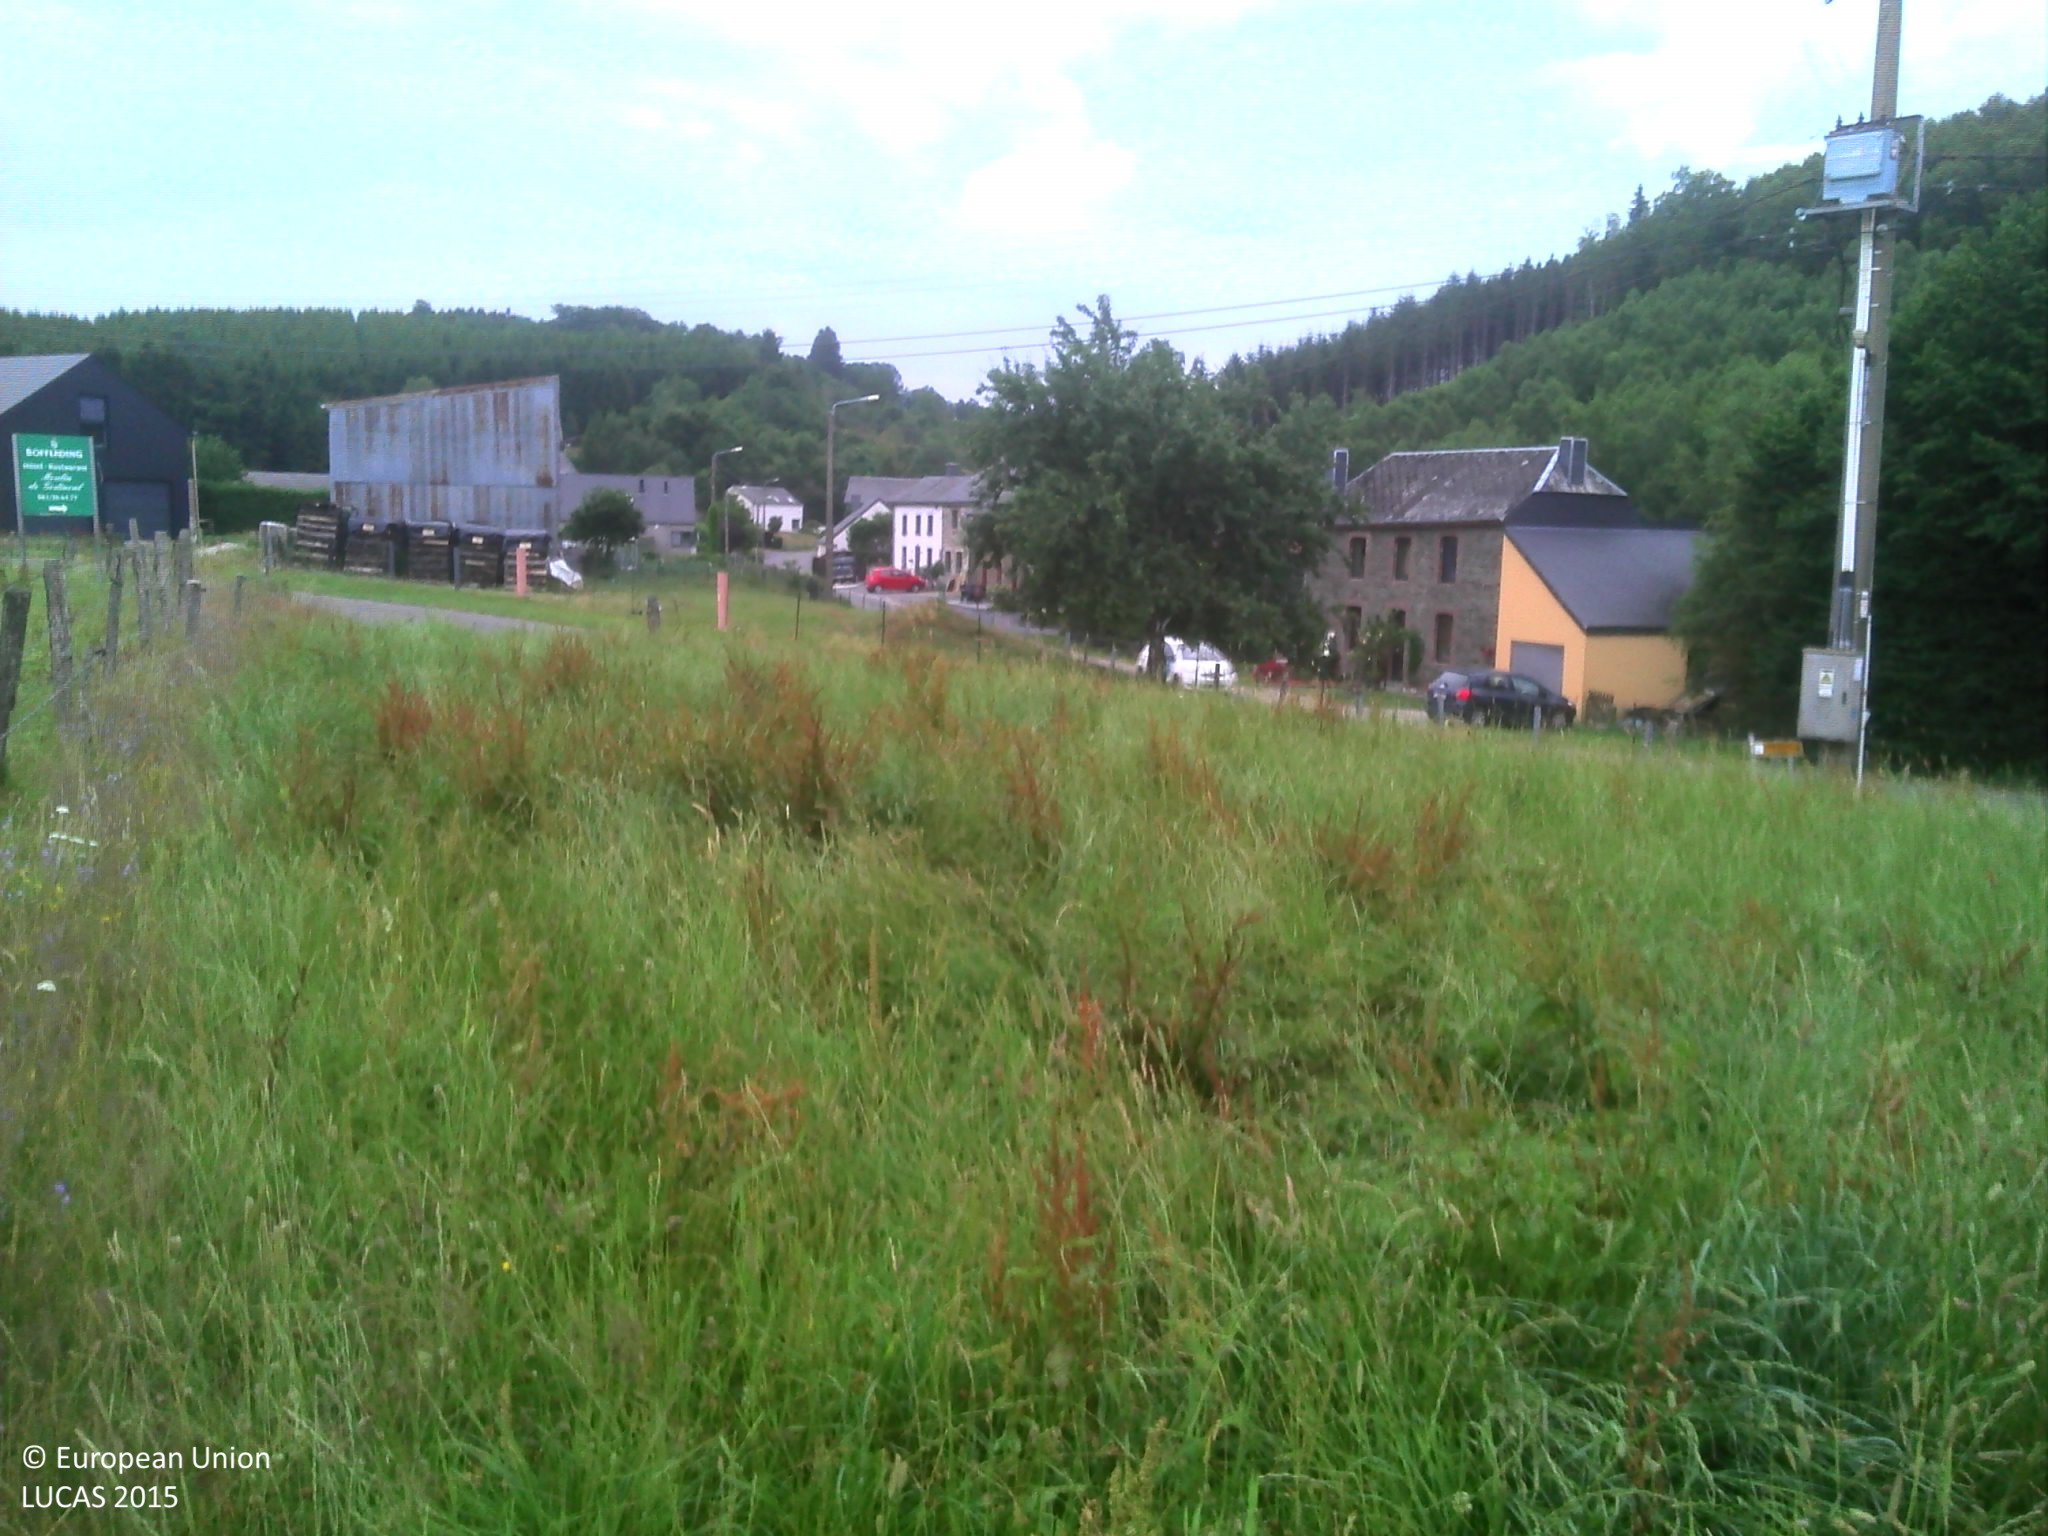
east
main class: Grassland
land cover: Grassland without tree/shrub cover
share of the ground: > 75 %
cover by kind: herbaceous plants 100 %
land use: Agriculture (excluding fallow land and kitchen gardens)
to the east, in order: Fences; Grassland without tree/shrub cover; Fences; Grassland without tree/shrub cover; Fences; Grass margins; Paved roads, cycling and walking lanes; Grass margins; Fences; Grassland with sparse tree/shrub cover; Artificial constructions in urban areas; Grassland without tree/shrub cover; Fences; Grassland without tree/shrub cover; Fences; Grassland without tree/shrub cover; Fences; Rivers and streams; Broadleaved woodland
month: July
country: BE
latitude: 49.9208
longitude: 5.6391
